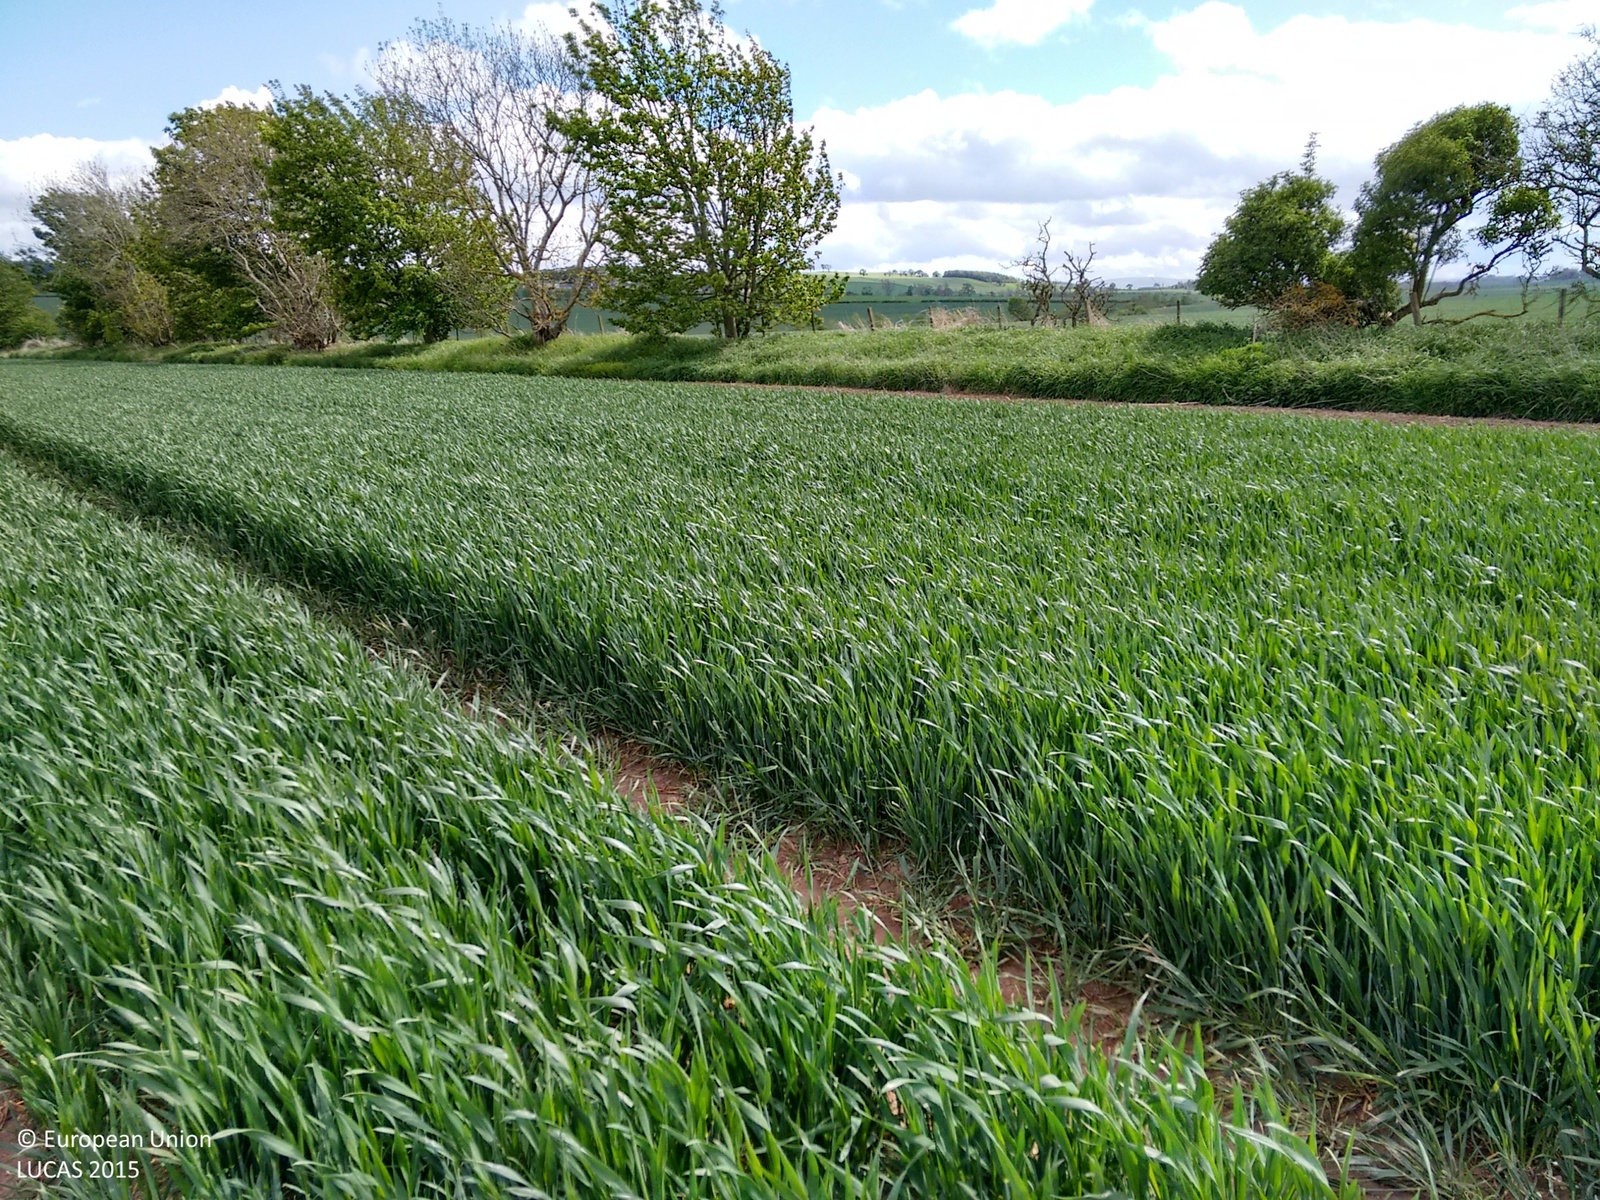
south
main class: Cropland
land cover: Barley
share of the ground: > 75 %
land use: Agriculture (excluding fallow land and kitchen gardens)
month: May
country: GB
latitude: 55.5786
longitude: -2.4484
